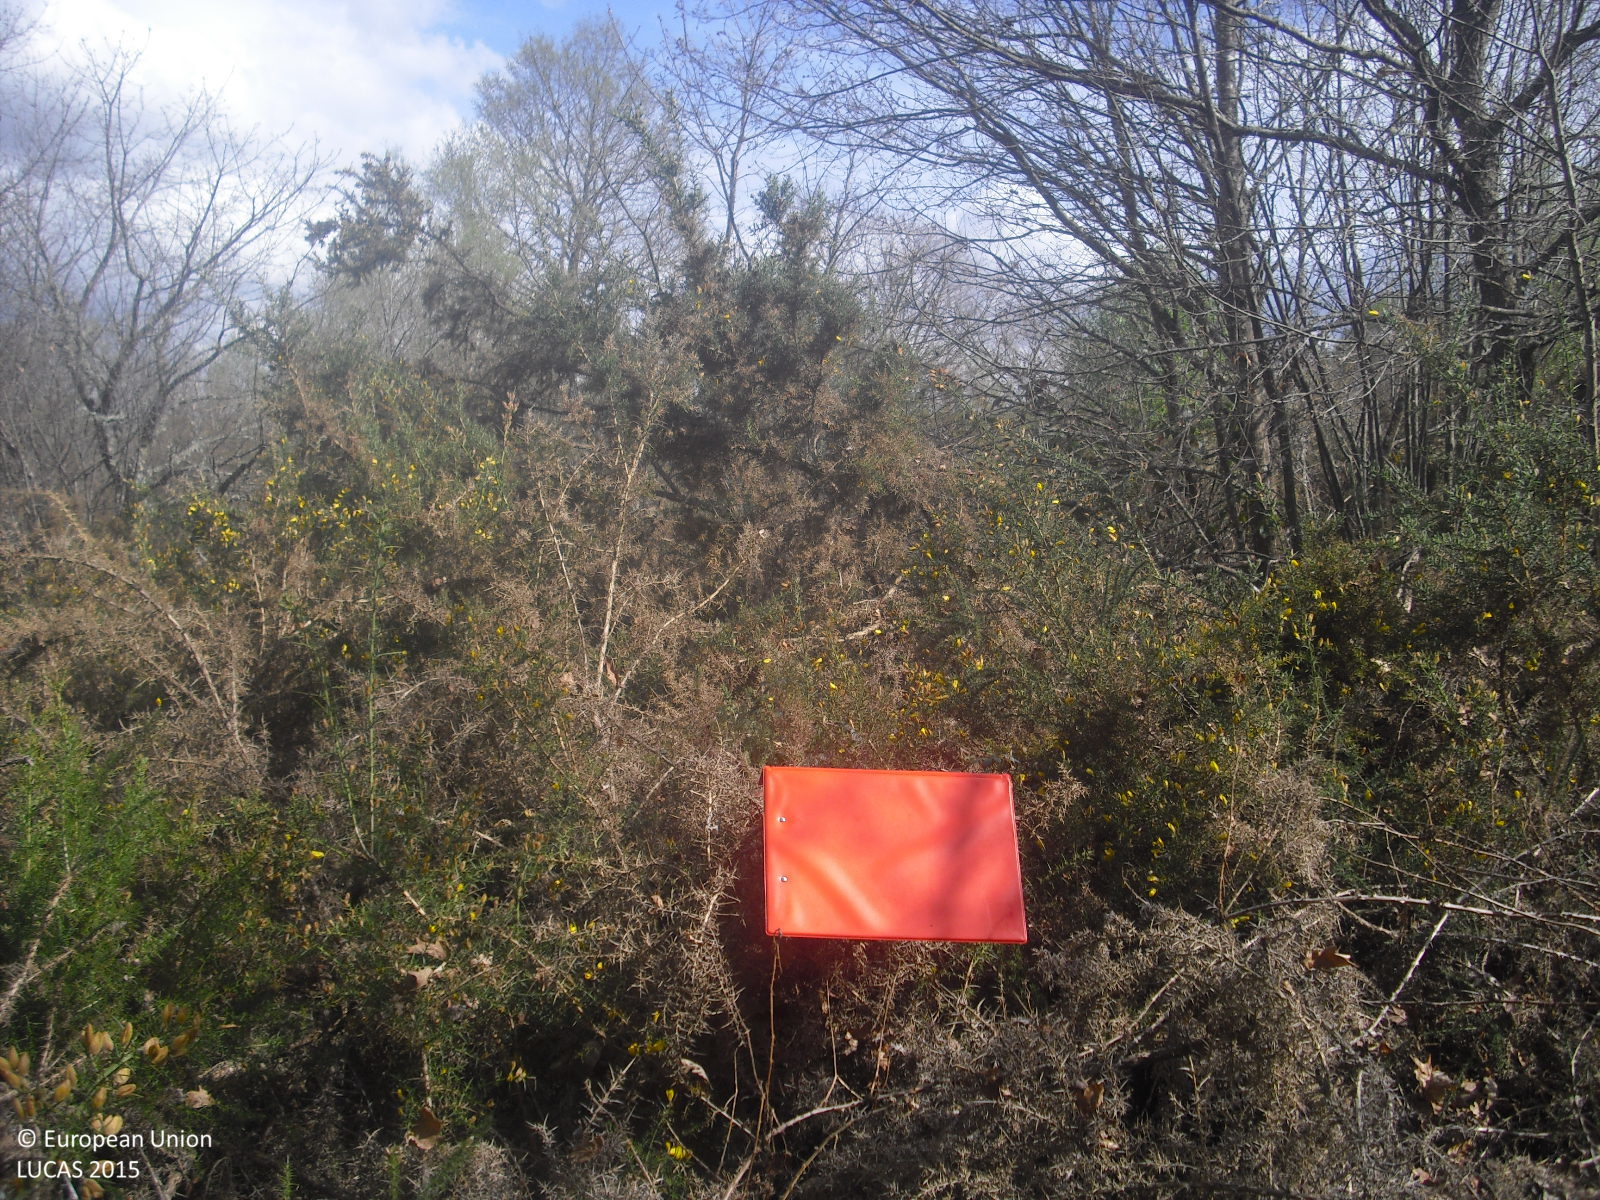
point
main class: Woodland
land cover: Broadleaved woodland
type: acidophilous oak and oak-birch forest
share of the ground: 50 - 75 %
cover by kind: broadleaved forest trees 70 %, shrubs 30 %
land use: Semi-natural and natural areas not in use
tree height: > 5 m
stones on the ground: < 10 %
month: April
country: ES
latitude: 42.0678
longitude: -7.8510
